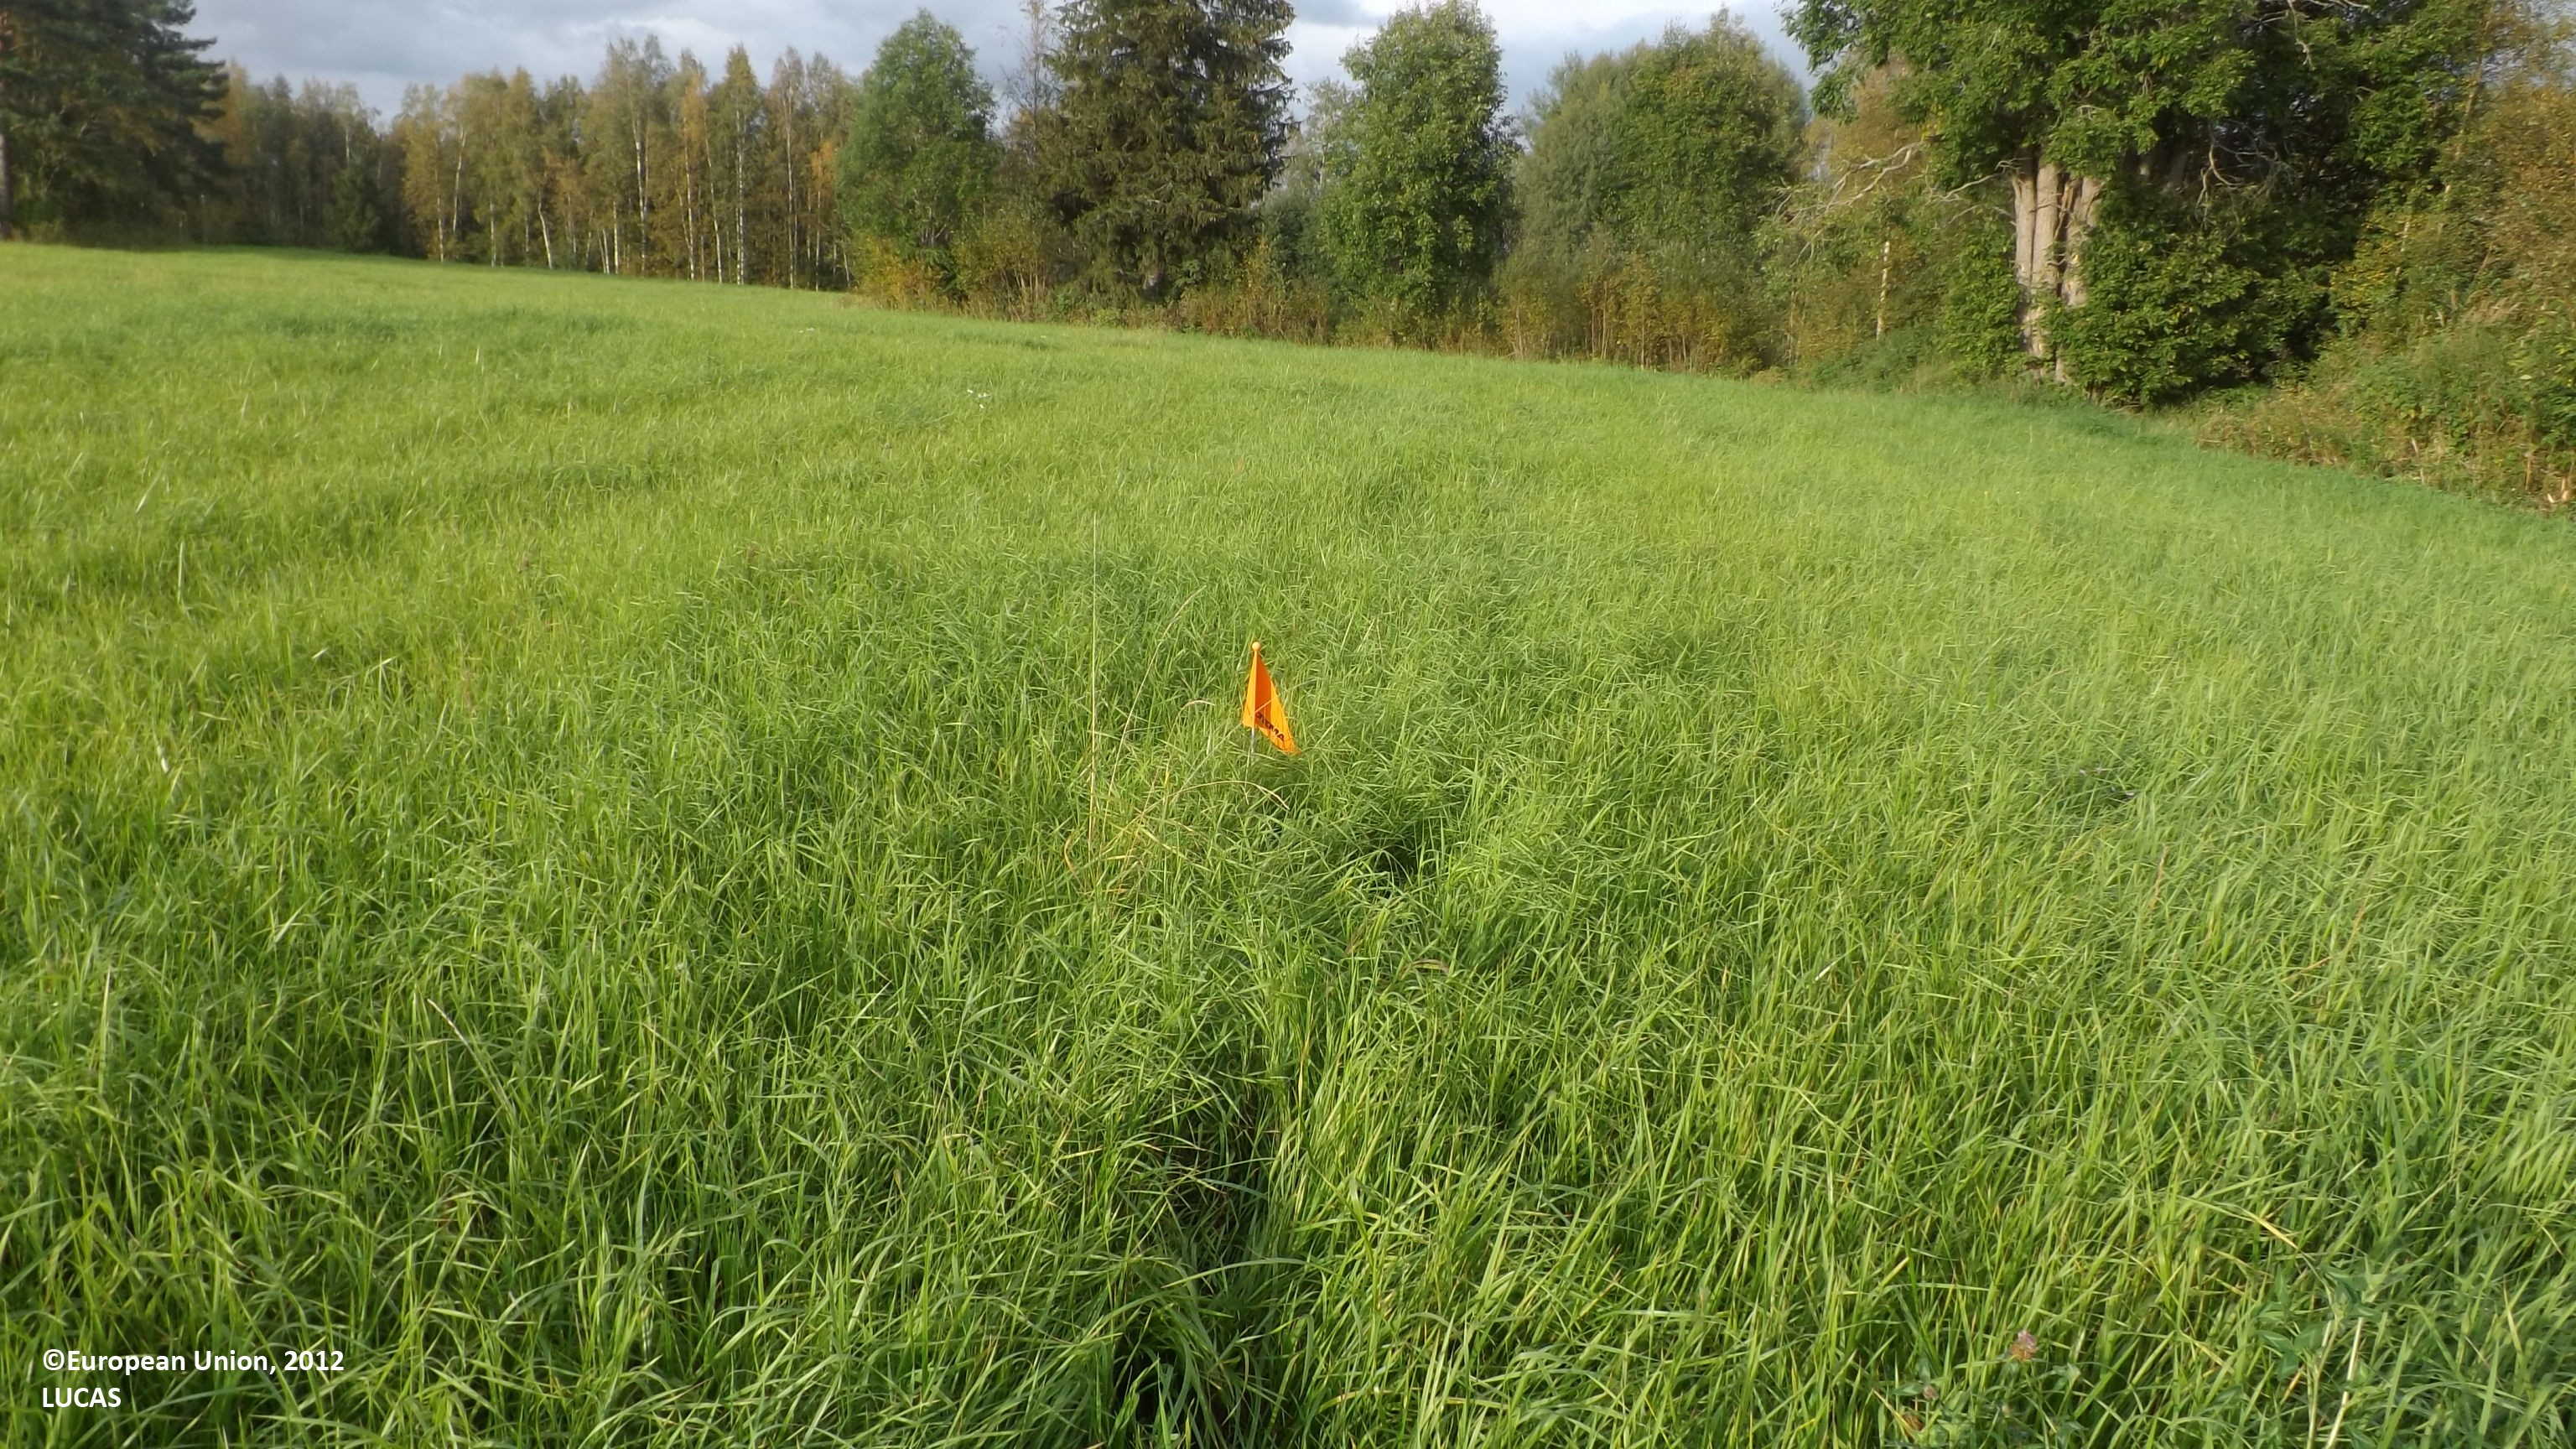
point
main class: Cropland
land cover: Temporary grasslands
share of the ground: > 75 %
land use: Agriculture (excluding fallow land and kitchen gardens)
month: August
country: FI
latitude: 63.8119
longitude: 23.3594
